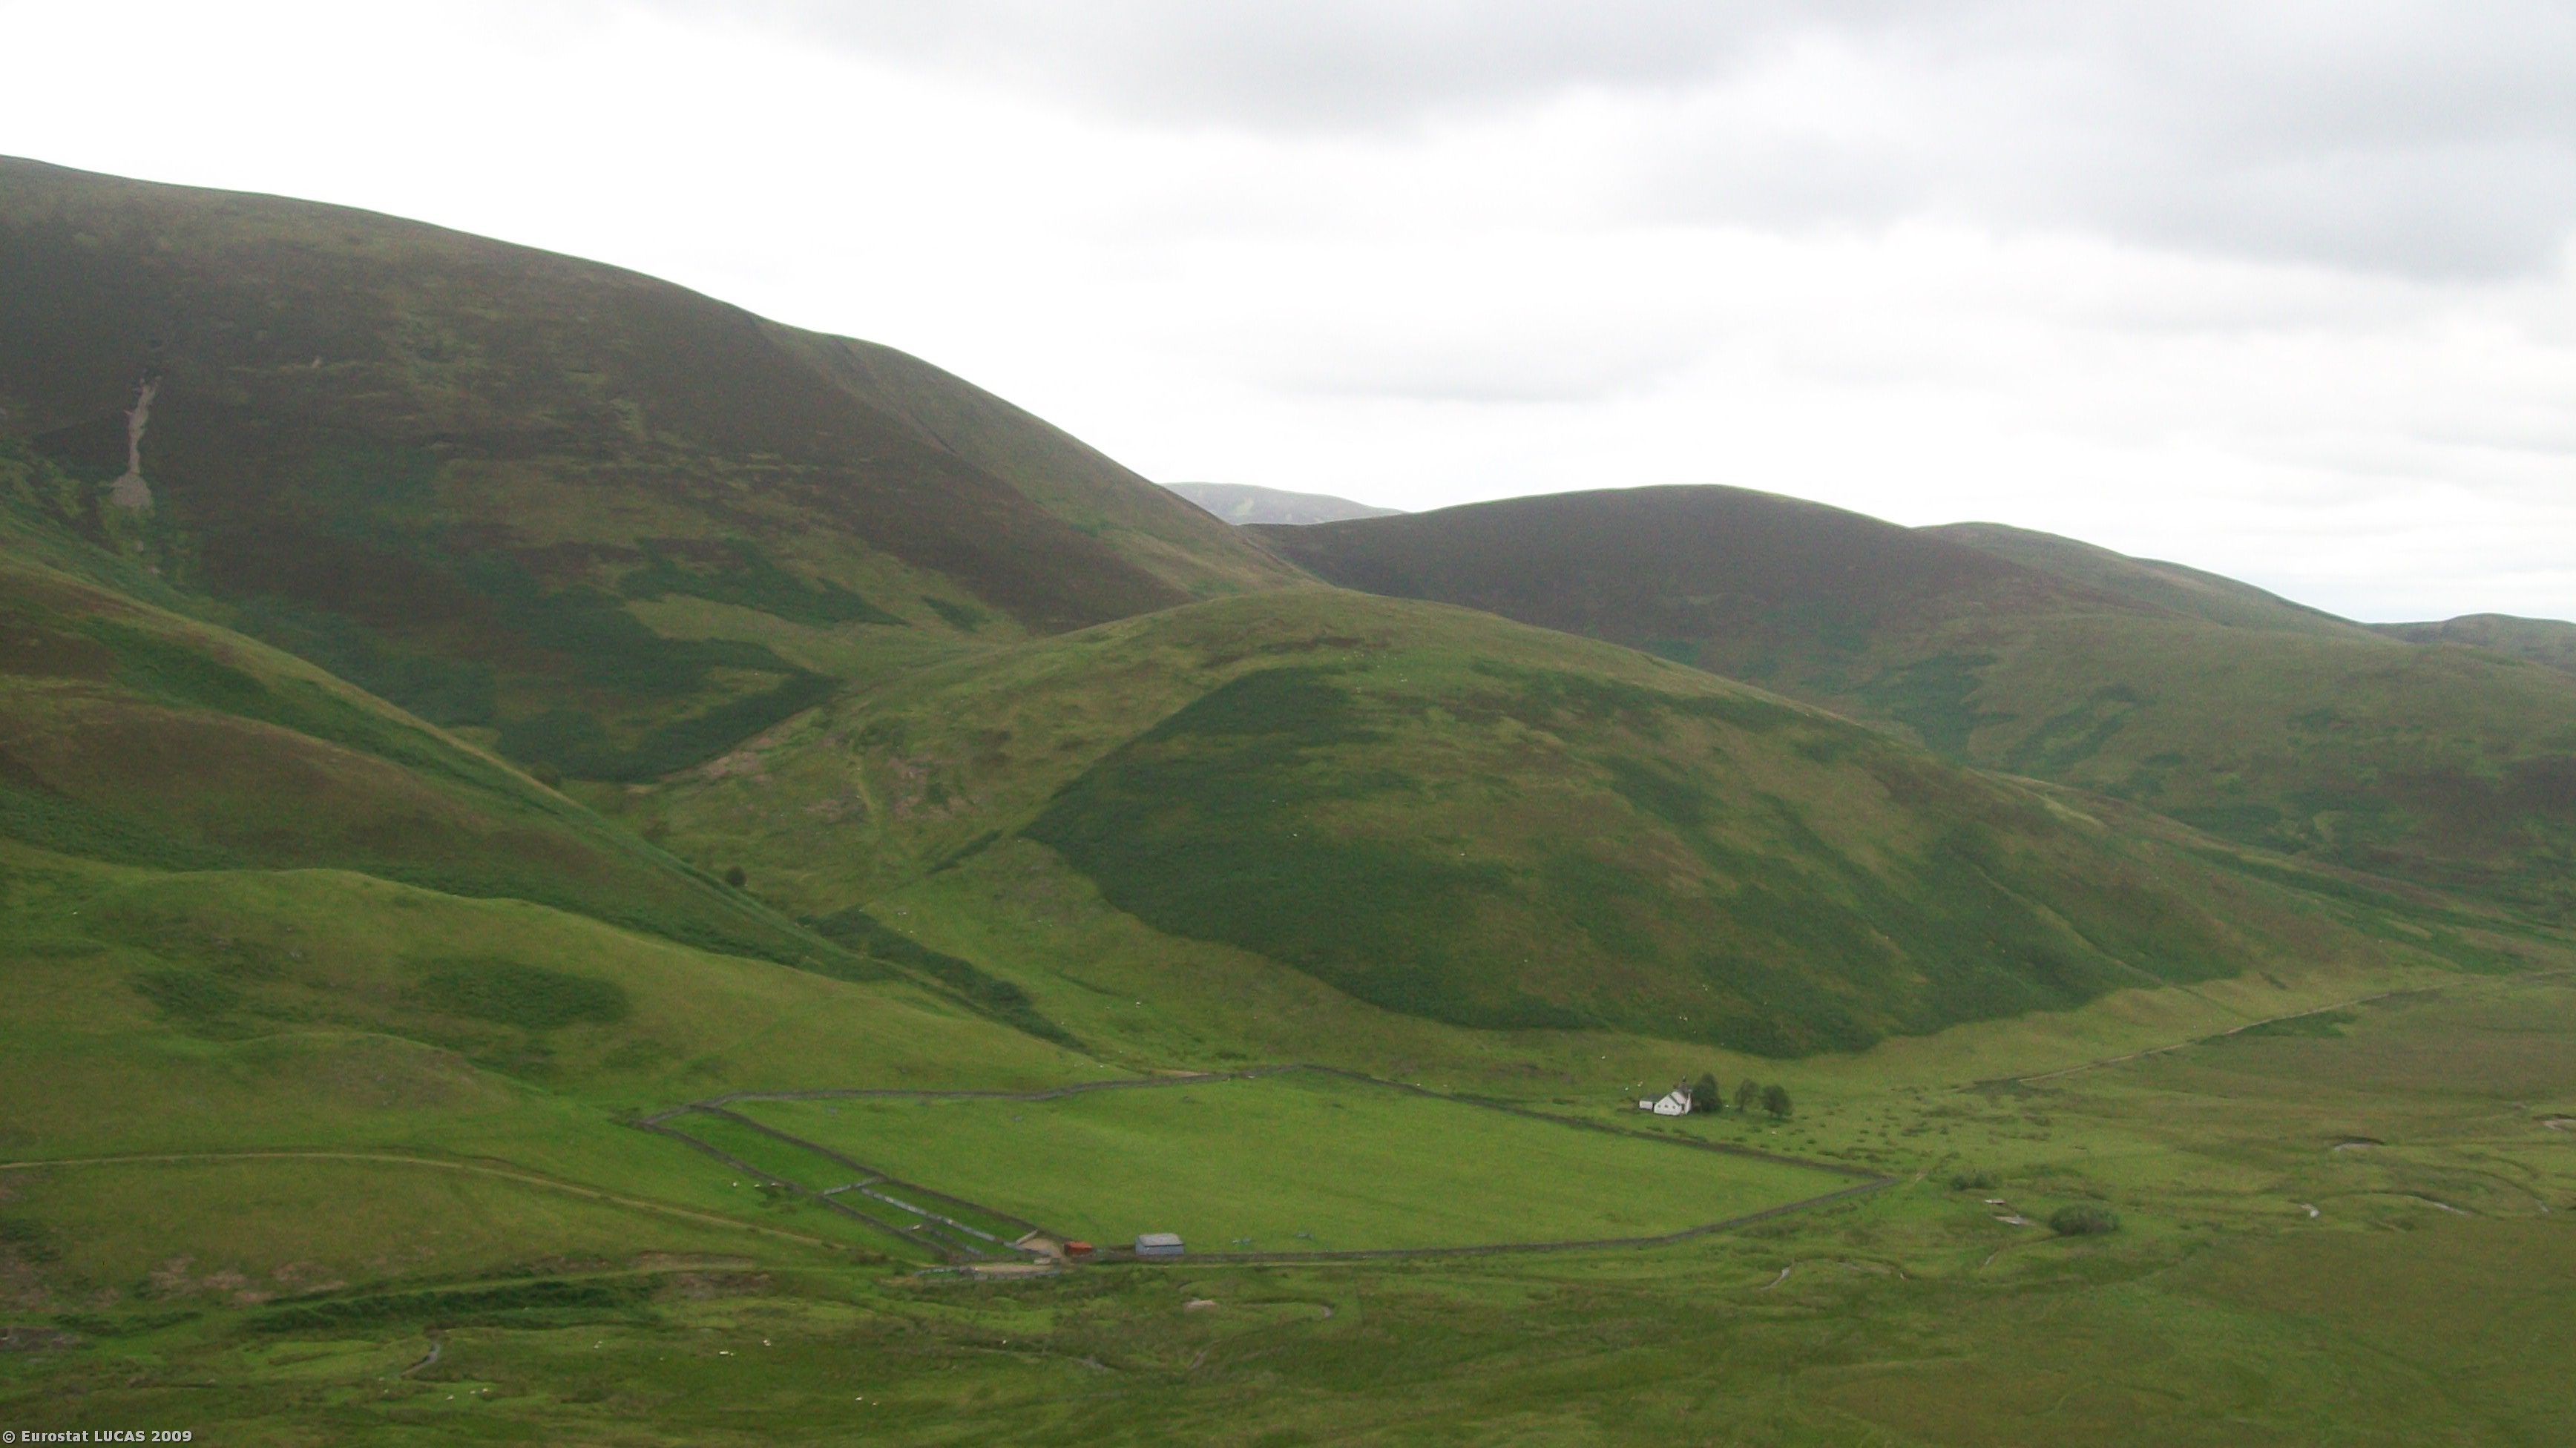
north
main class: Shrubland
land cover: Shrubland without tree cover
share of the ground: > 75 %
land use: Agriculture (excluding fallow land and kitchen gardens)
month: August
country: GB
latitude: 55.5109
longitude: -3.4588
